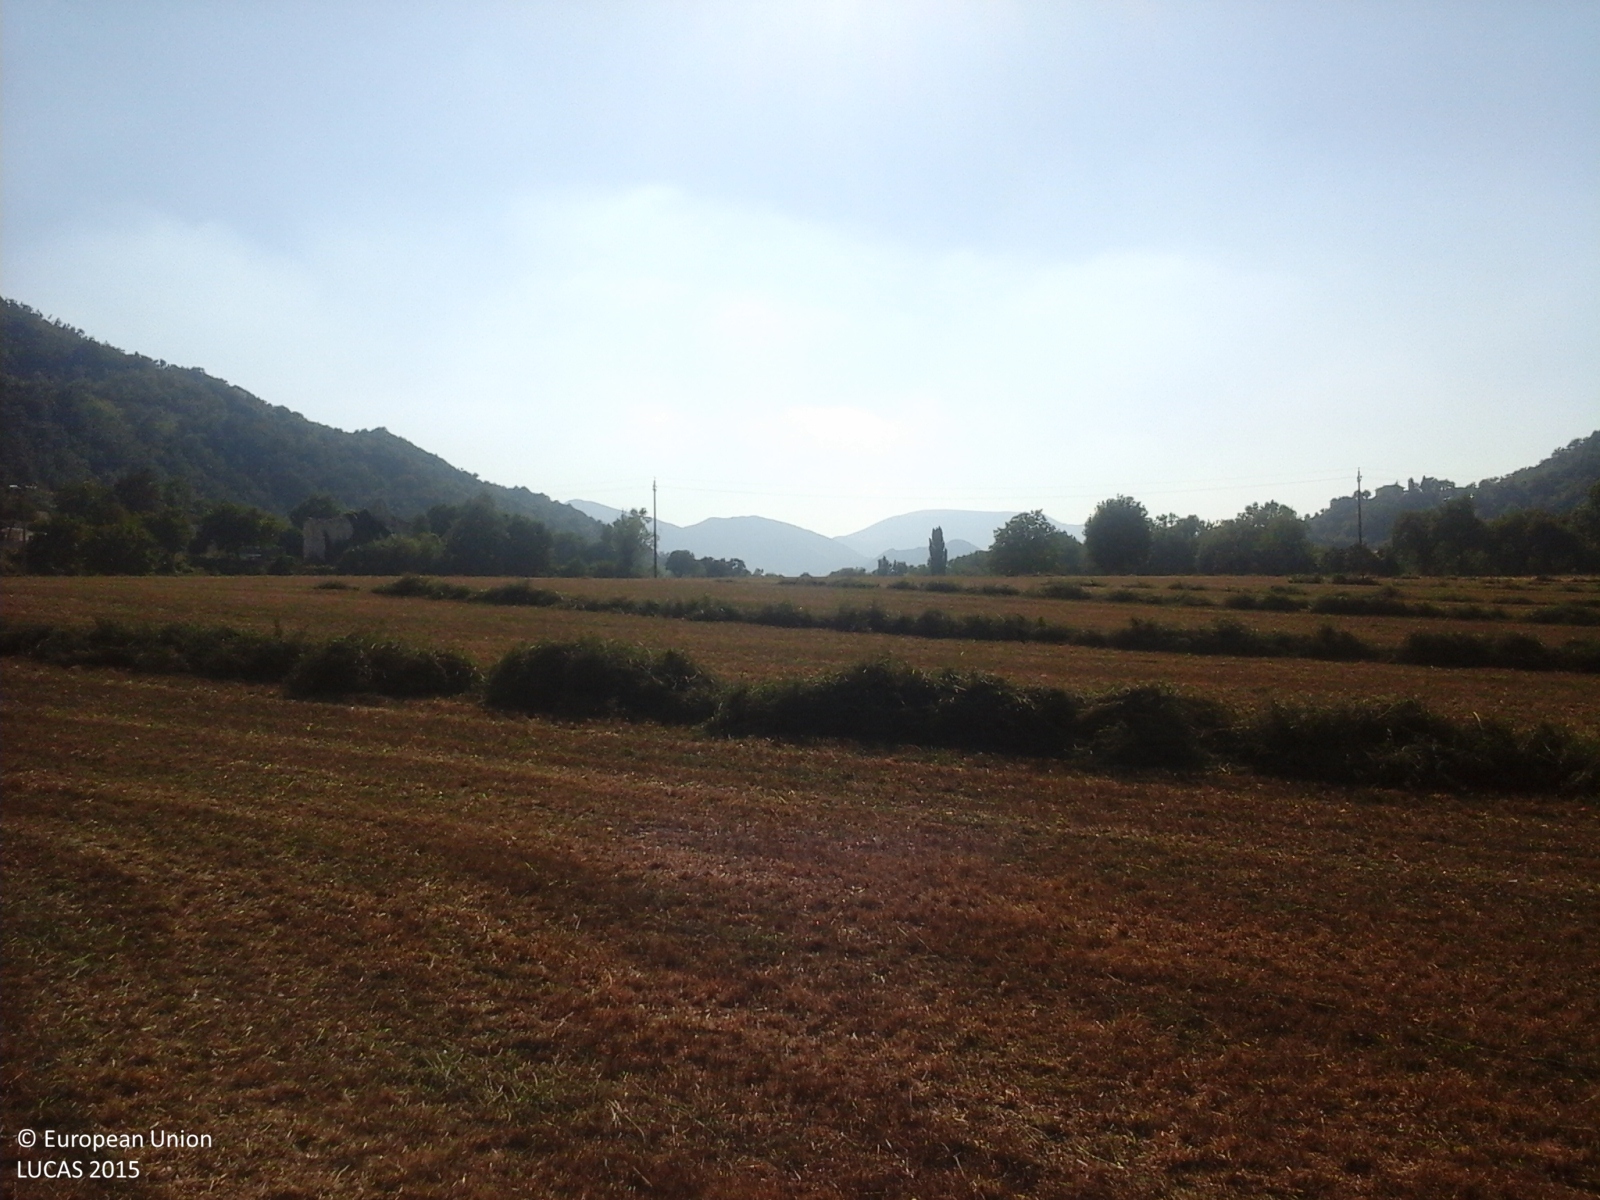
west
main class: Cropland
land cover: Lucerne
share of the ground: > 75 %
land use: Agriculture (excluding fallow land and kitchen gardens)
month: August
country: IT
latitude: 43.6126
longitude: 12.6572
